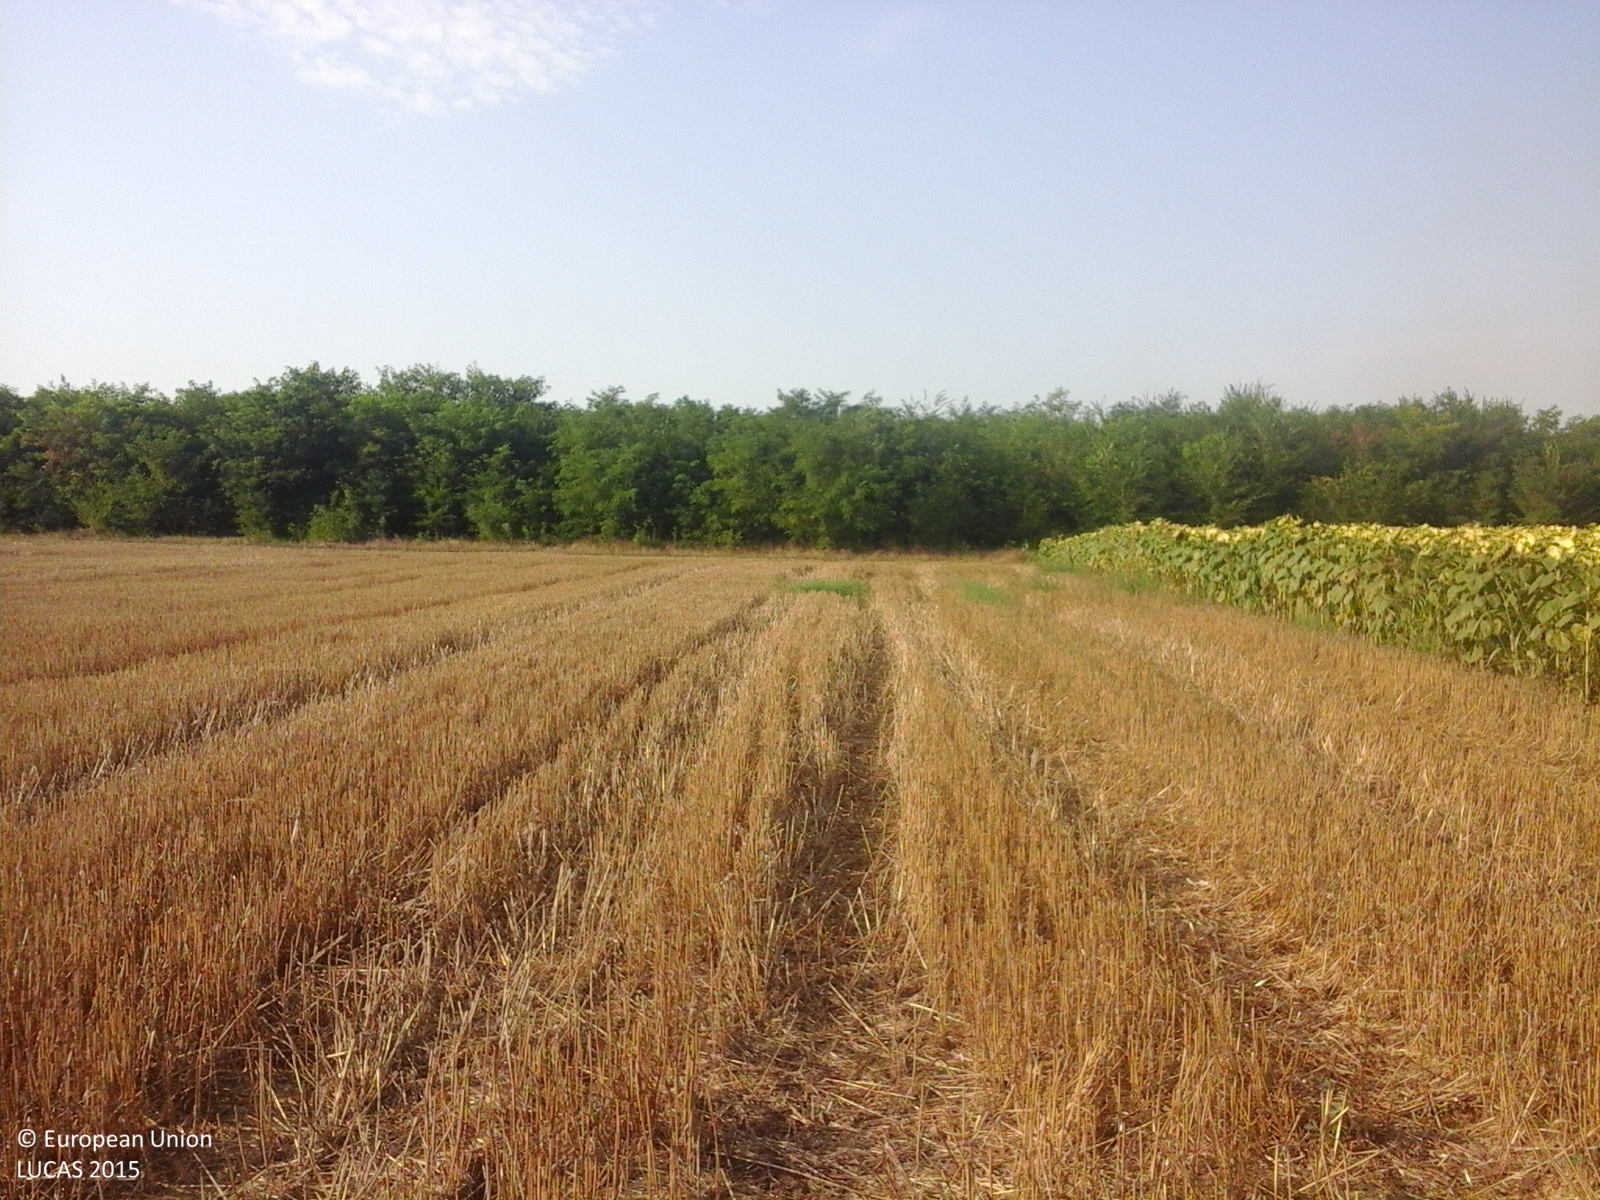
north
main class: Cropland
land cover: Common wheat
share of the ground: > 75 %
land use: Agriculture (excluding fallow land and kitchen gardens)
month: August
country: RO
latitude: 44.0582
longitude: 28.2740
